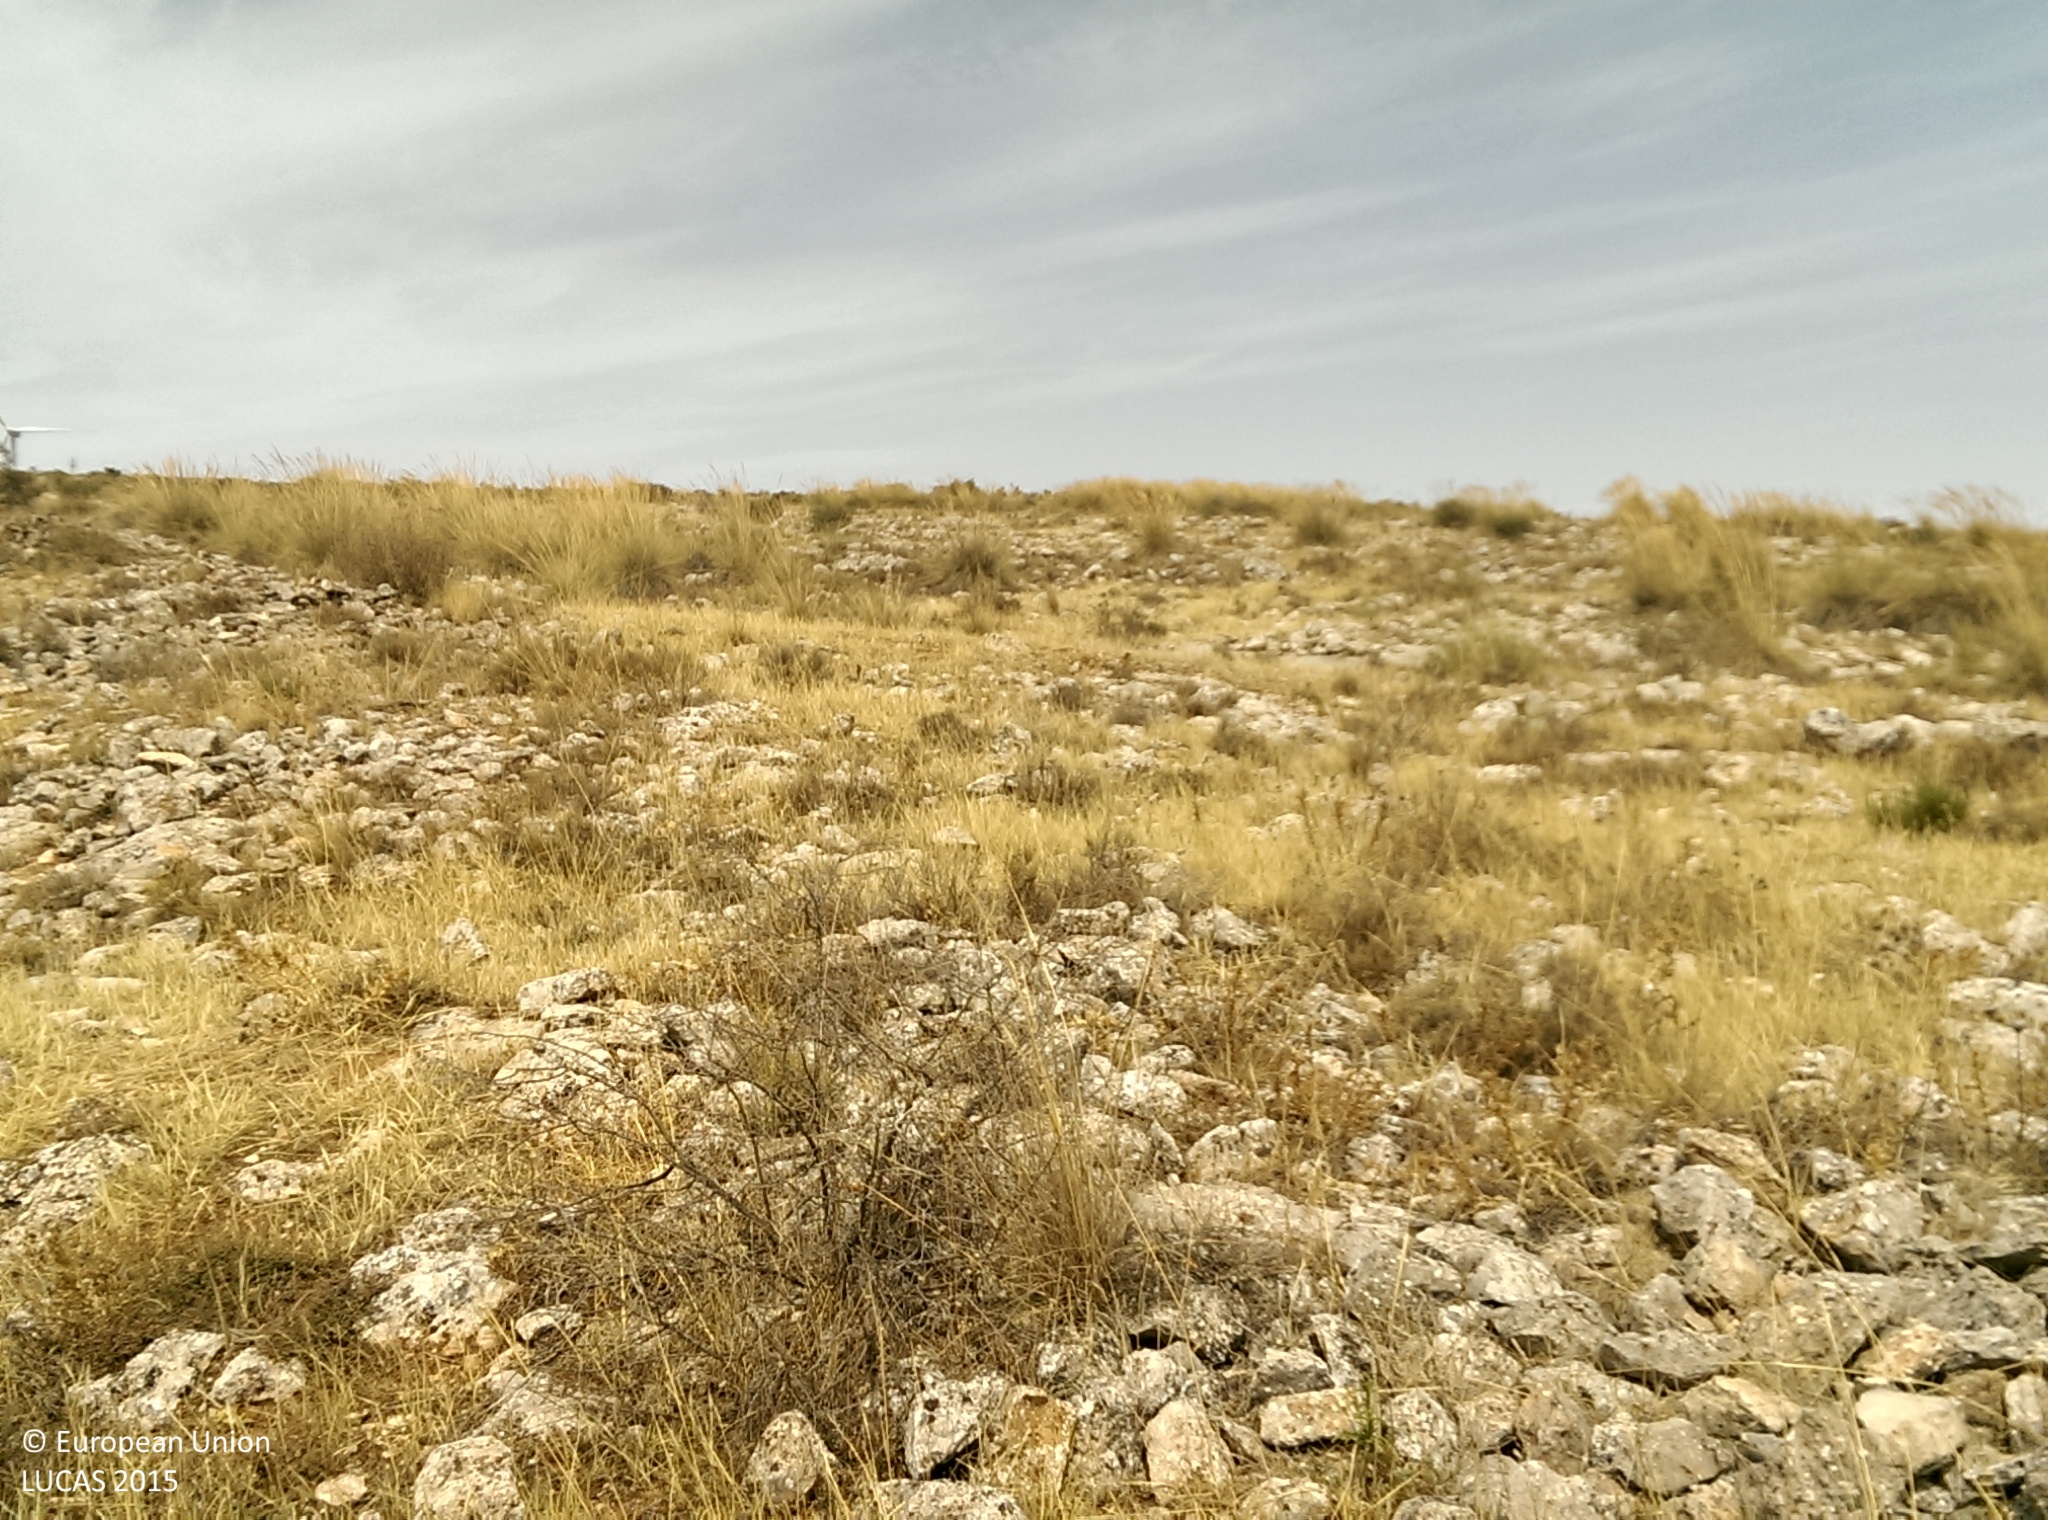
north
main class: Grassland
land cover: Grassland without tree/shrub cover
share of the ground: 50 - 75 %
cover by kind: herbaceous plants 75 %, consolidated bare surface 15 %, unconsolidated bare surface 10 %
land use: Abandoned areas
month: August
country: ES
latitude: 37.0132
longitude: -3.6650
